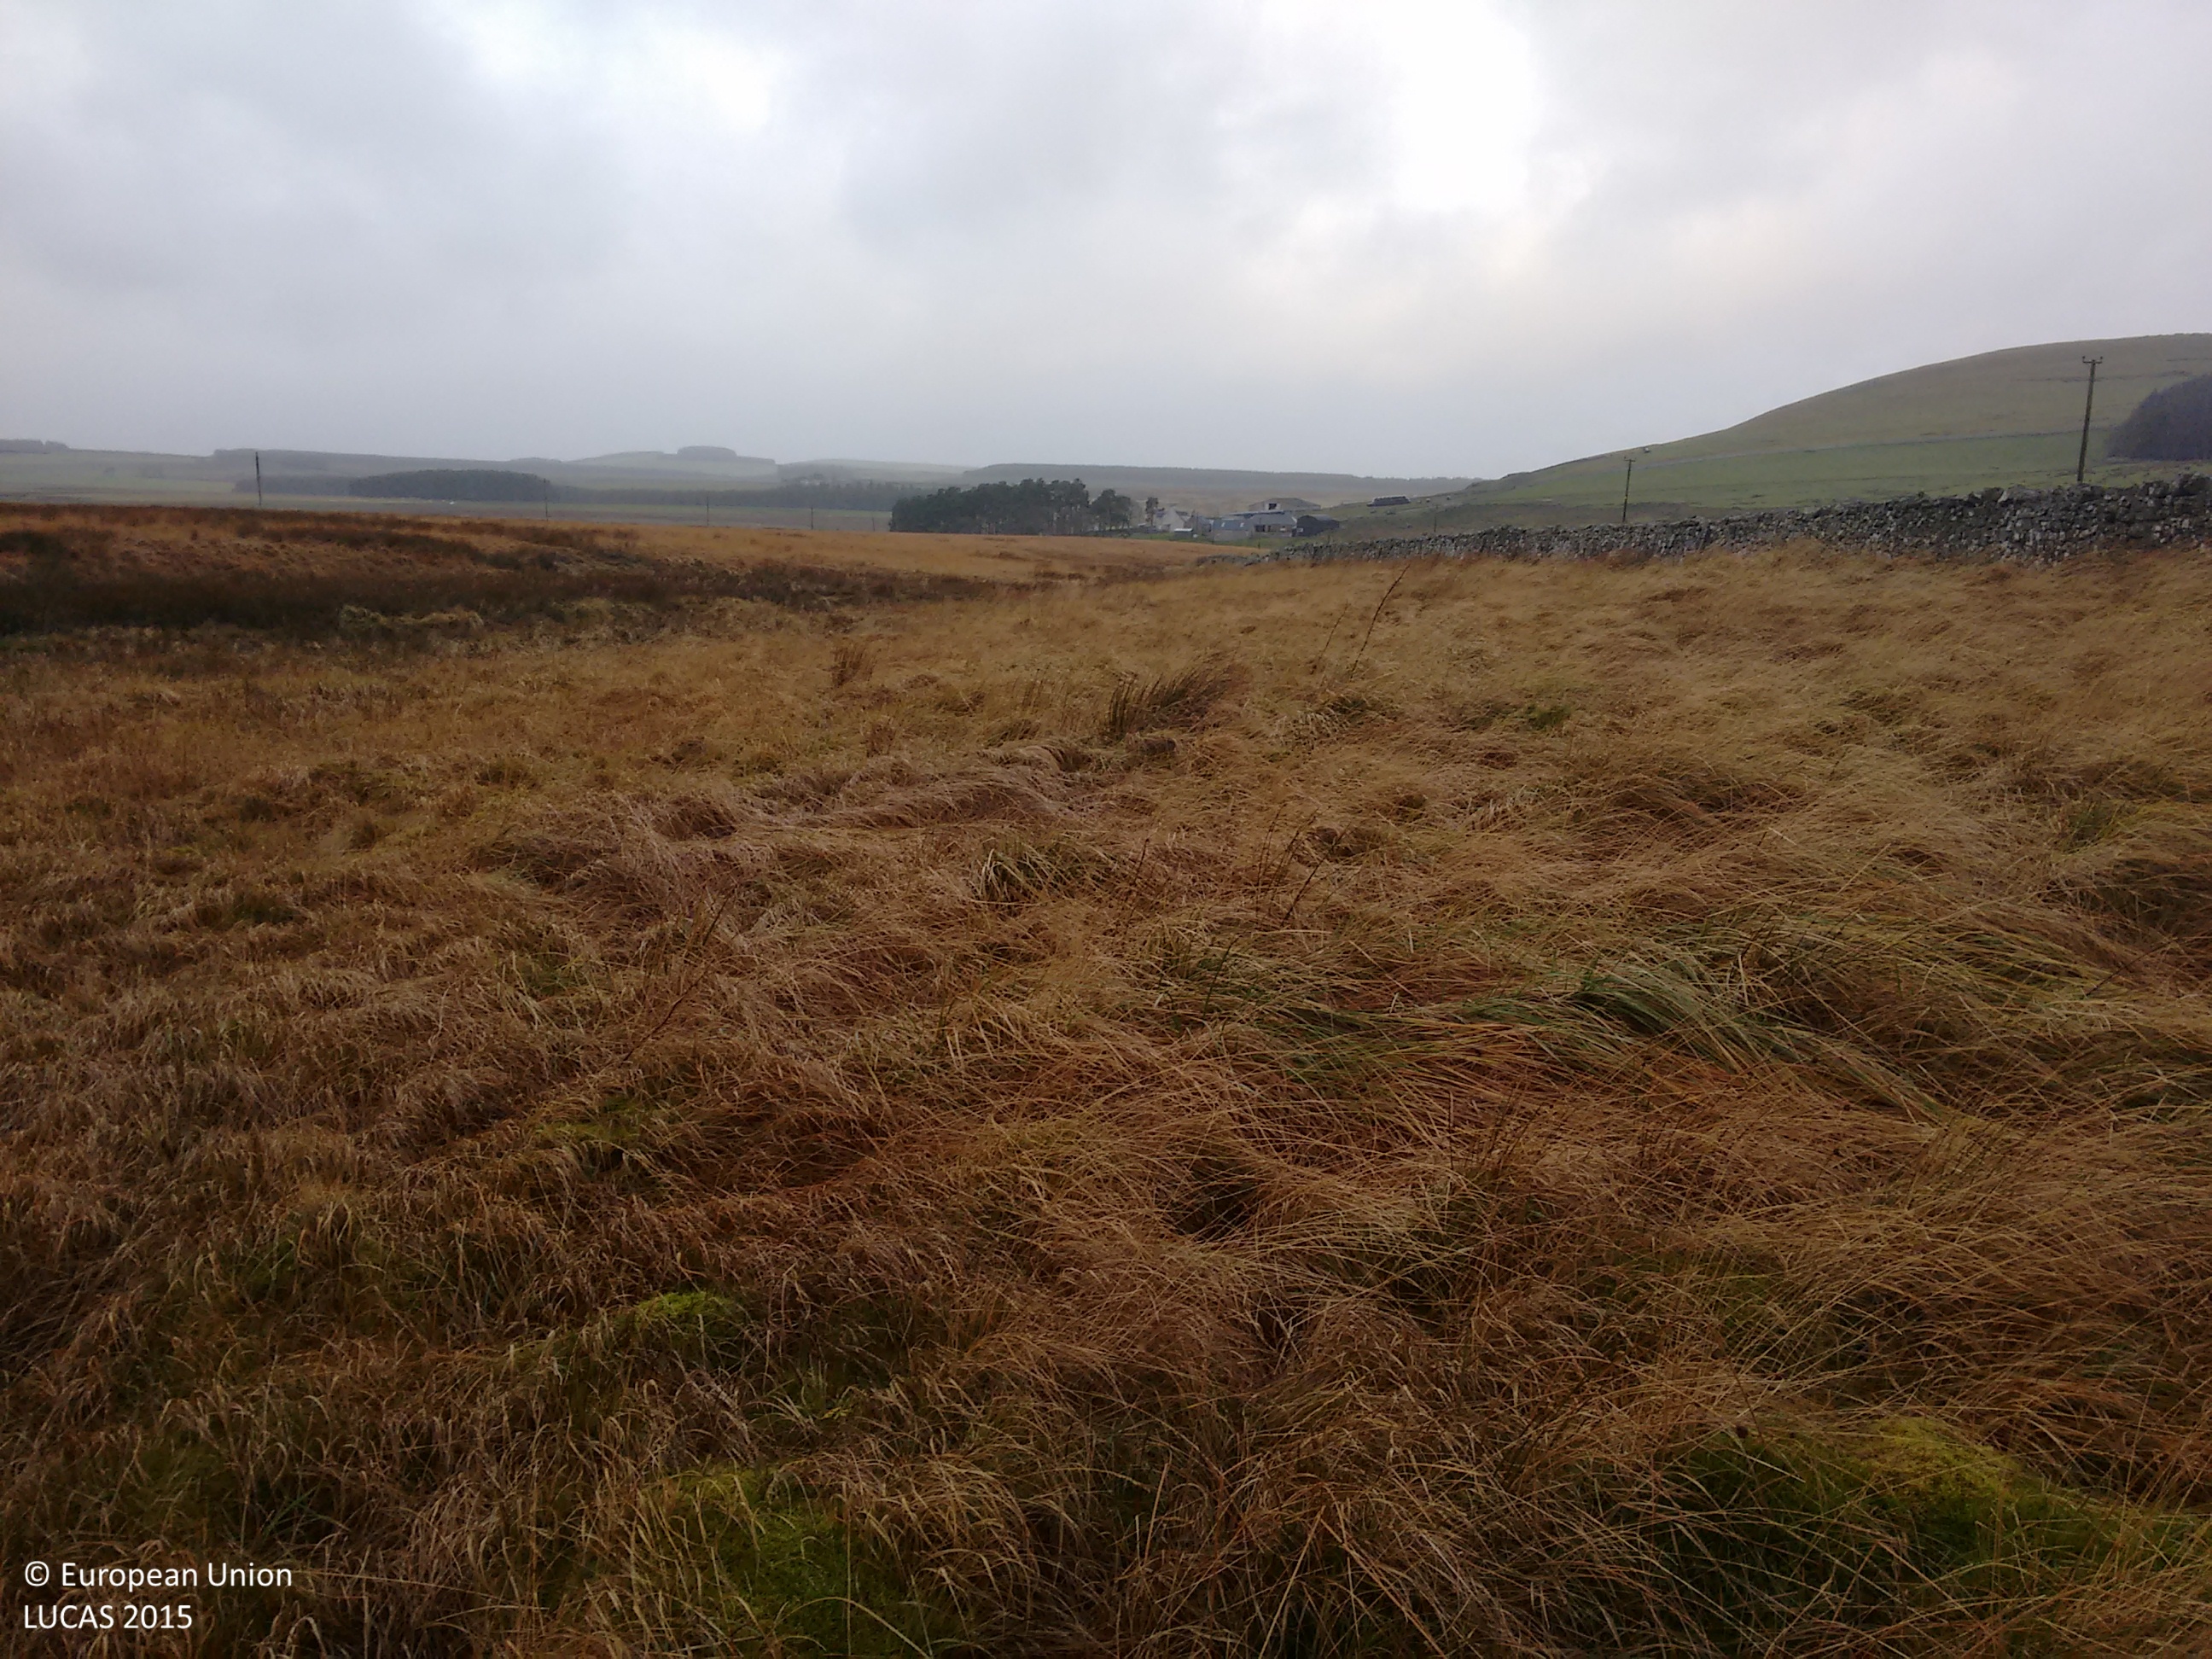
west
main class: Grassland
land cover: Grassland without tree/shrub cover
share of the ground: > 75 %
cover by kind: herbaceous plants 100 %
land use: Agriculture (excluding fallow land and kitchen gardens)
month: December
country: GB
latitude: 55.4197
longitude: -2.3982
